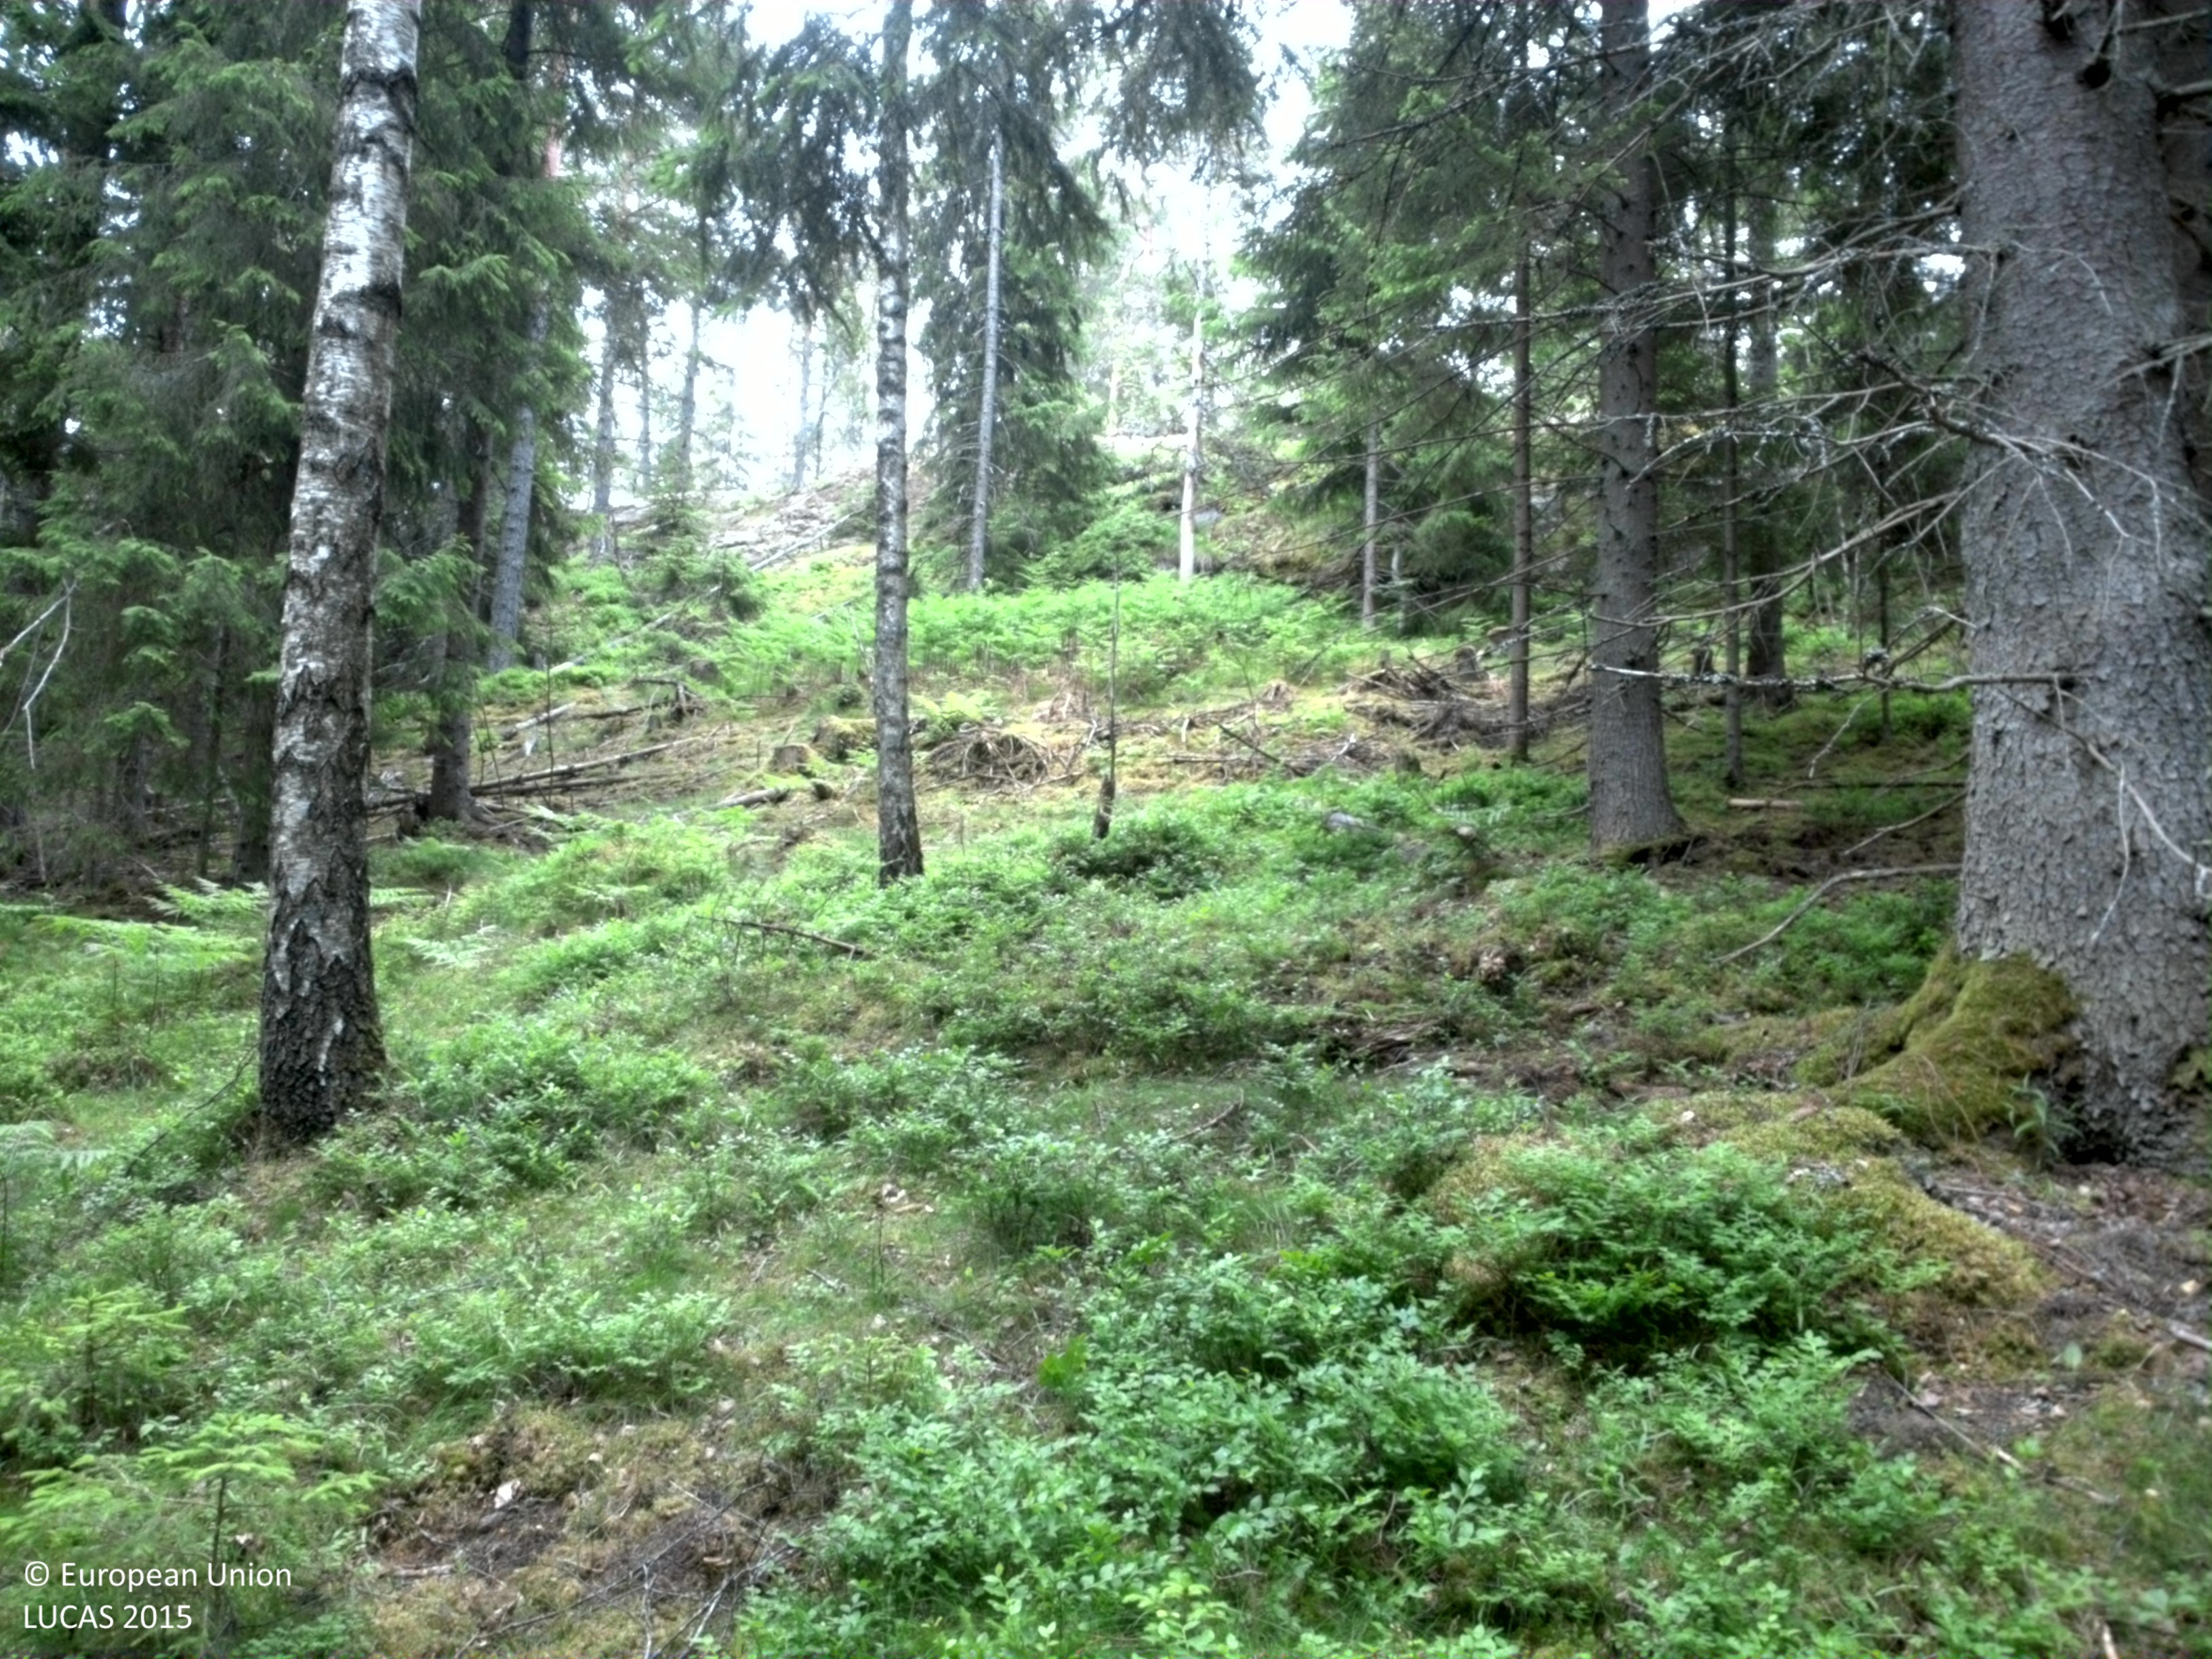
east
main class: Woodland
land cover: Spruce dominated coniferous woodland
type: boreal forest
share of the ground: 25 - 50 %
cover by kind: herbaceous plants 55 %, coniferous forest trees 30 %, lichens and mosses 10 %, broadleaved forest trees 5 %
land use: Forestry
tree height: > 5 m
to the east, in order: Spruce dominated coniferous woodland; Pine dominated coniferous woodland; Tracks; Pine dominated mixed woodland; Spruce dominated coniferous woodland; Pine dominated coniferous woodland
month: June
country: SE
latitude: 58.6980
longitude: 15.6021
